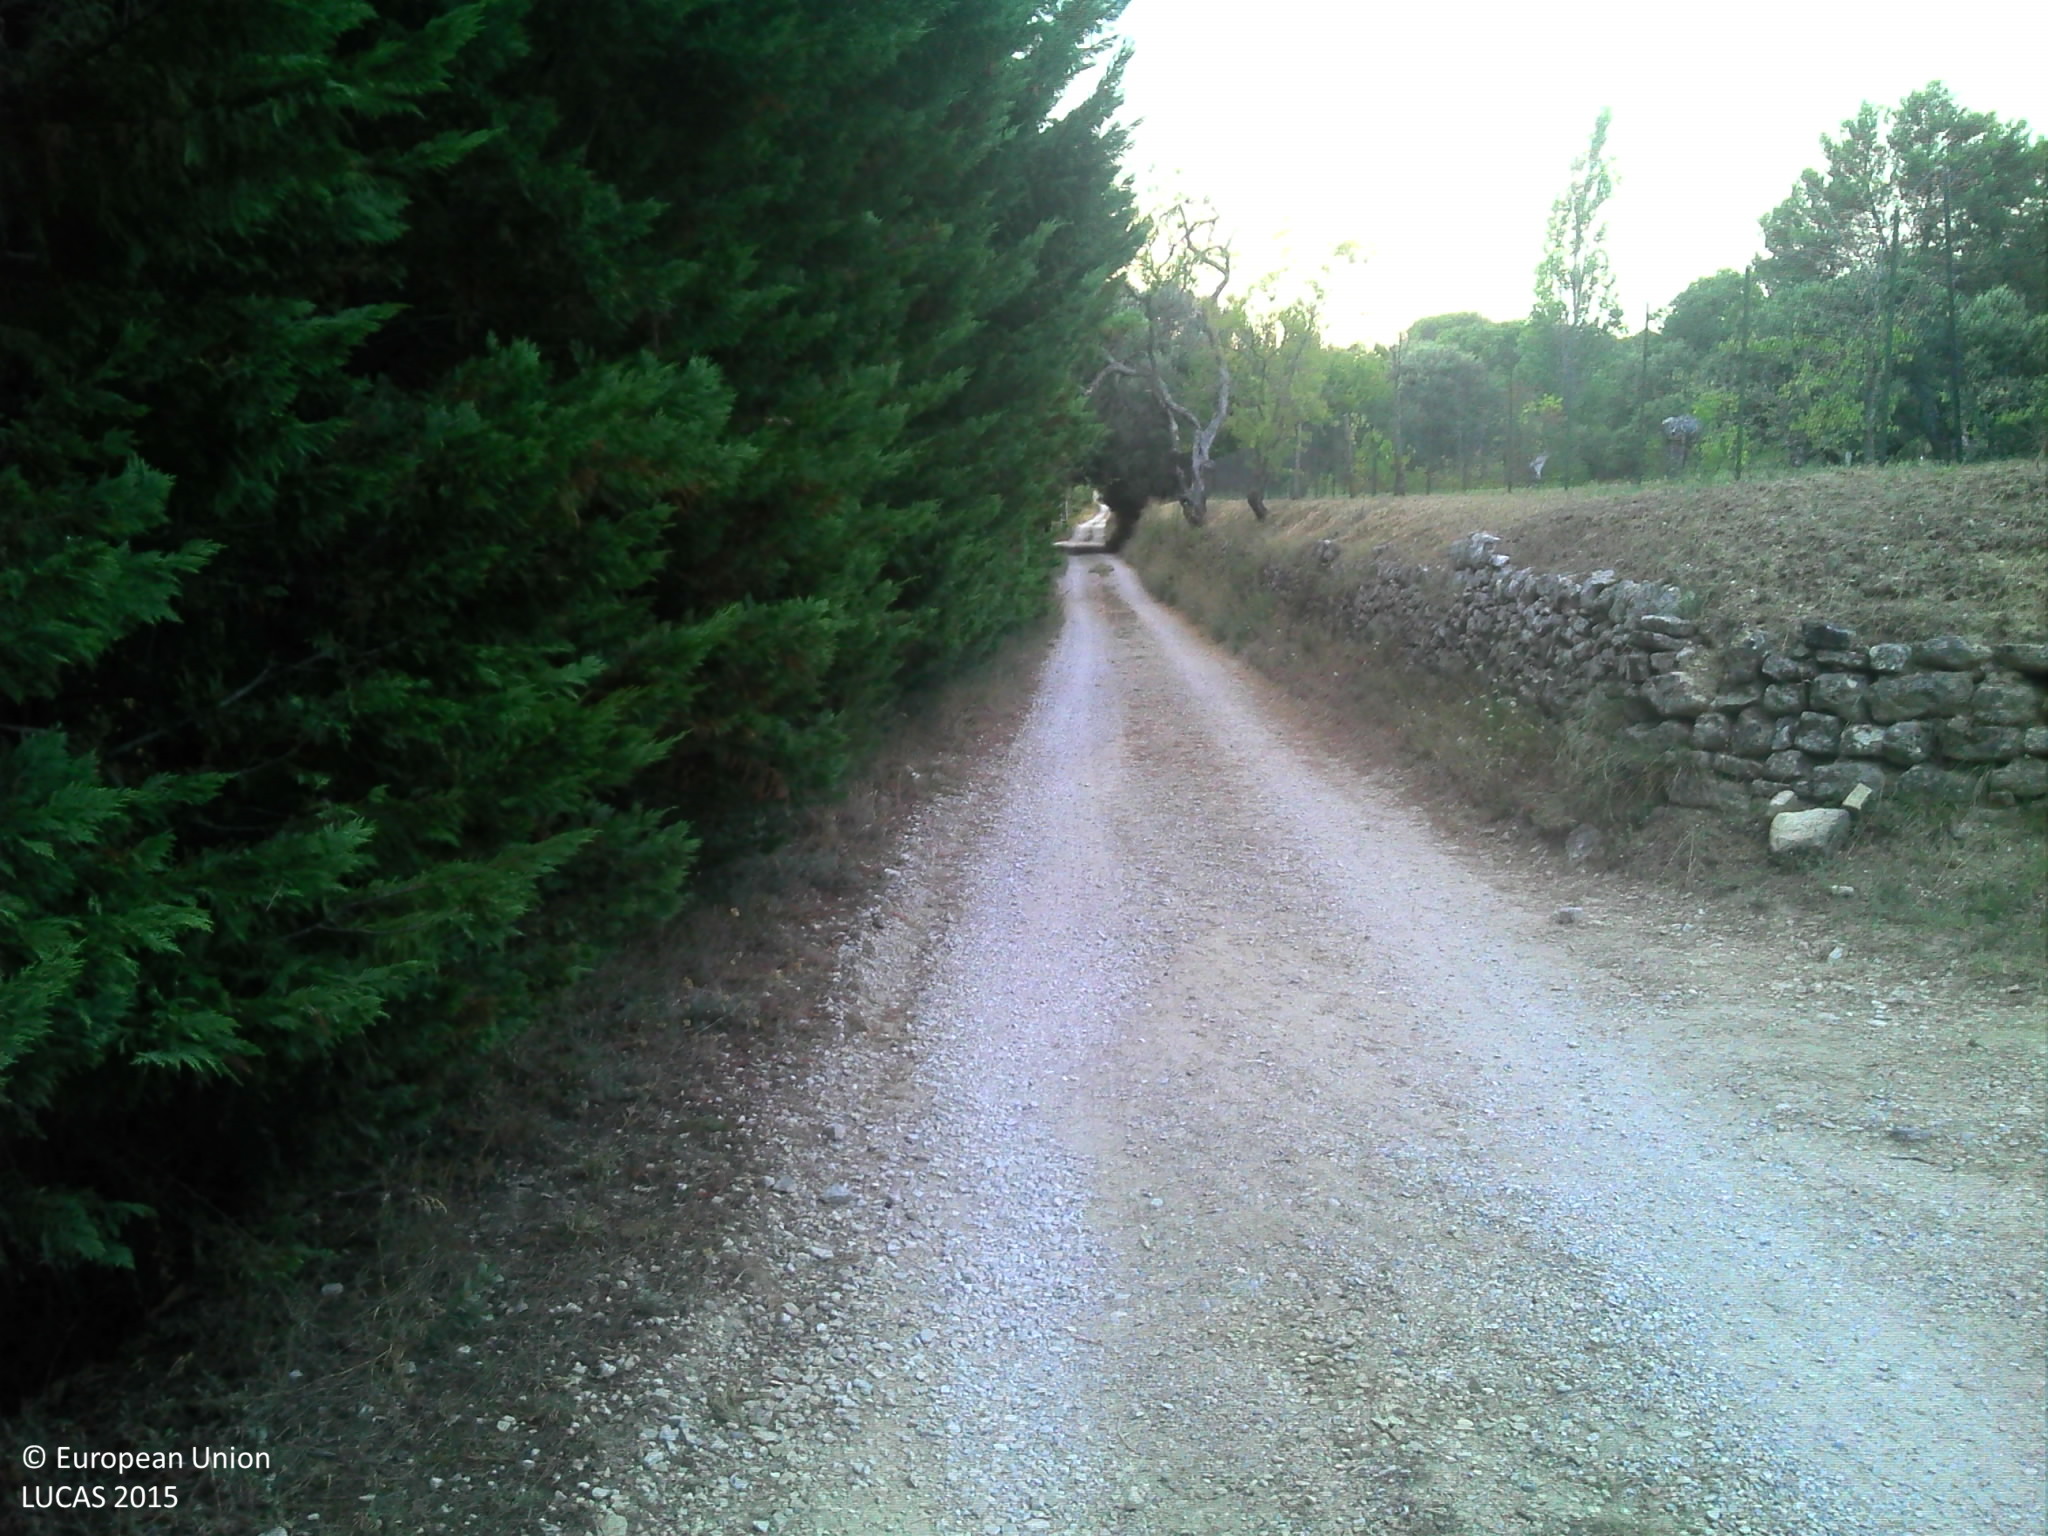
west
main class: Grassland
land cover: Grassland with sparse tree/shrub cover
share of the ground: > 75 %
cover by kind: herbaceous plants 95 %, broadleaved forest trees 5 %
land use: Residential
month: August
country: FR
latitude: 43.6517
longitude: 5.3847
